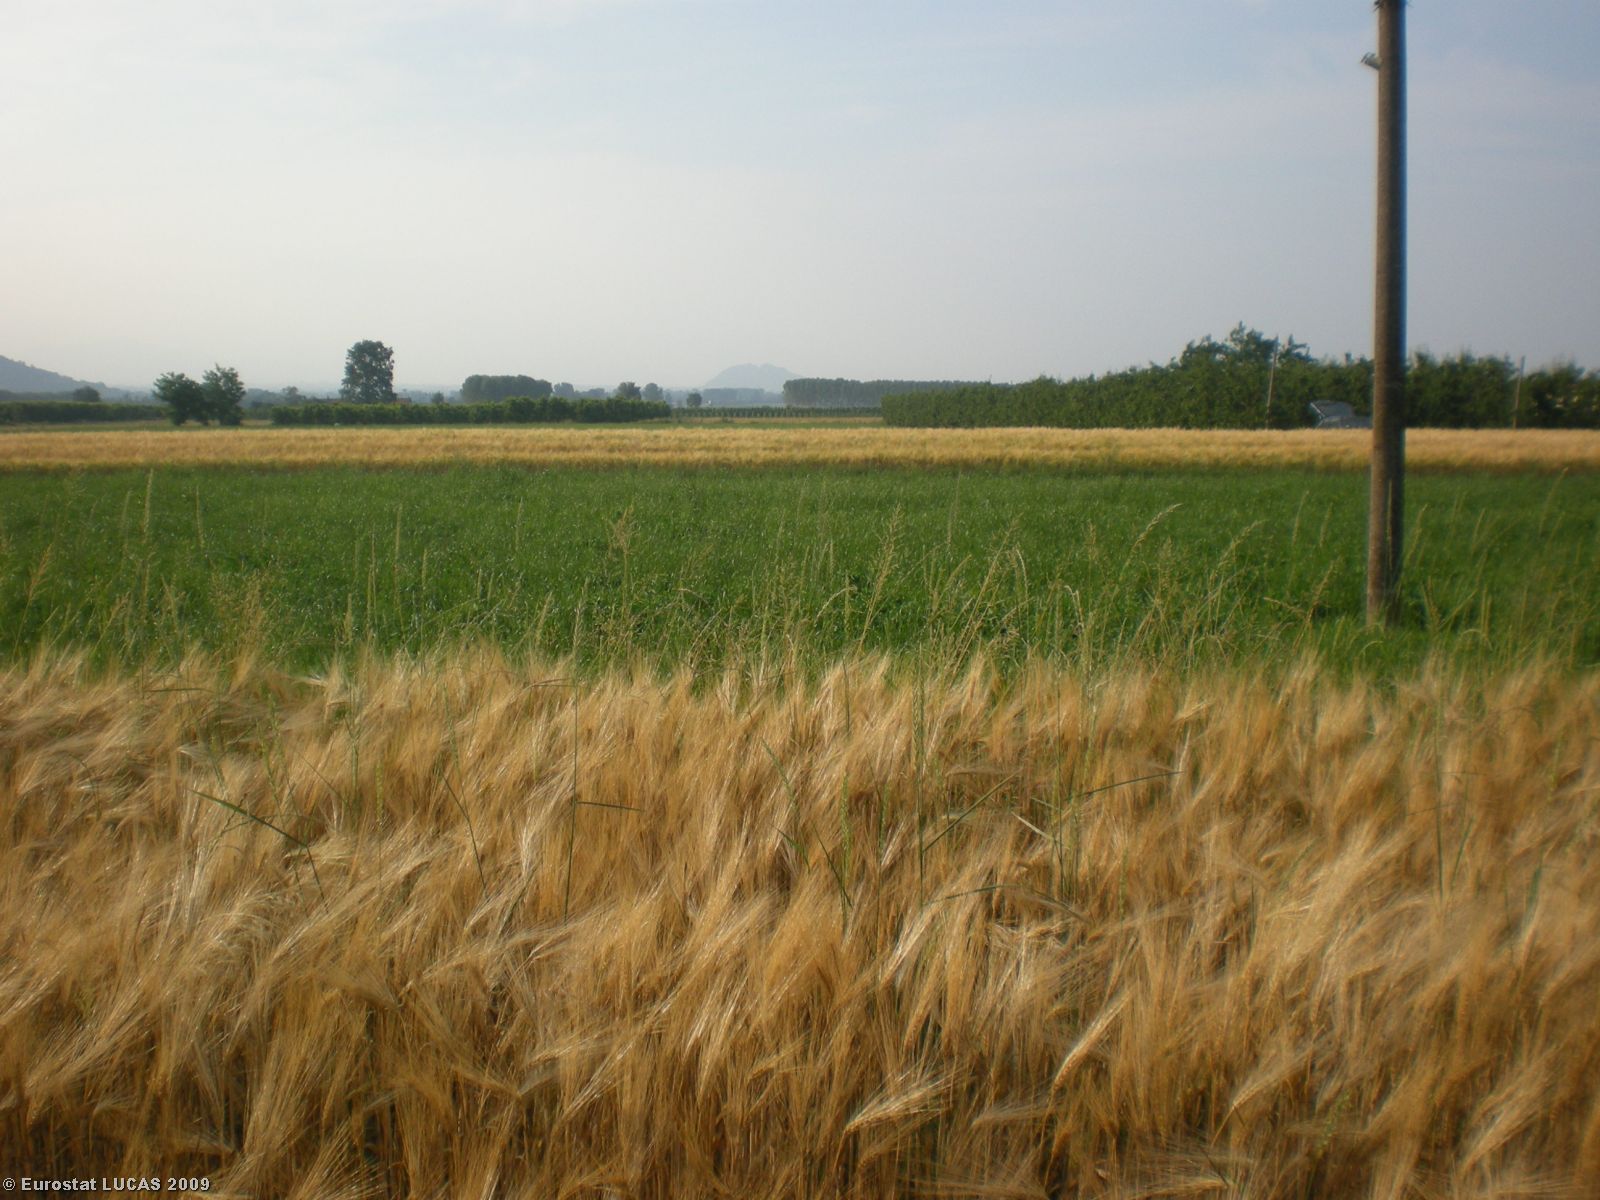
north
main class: Cropland
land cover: Barley
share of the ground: > 75 %
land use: Agriculture (excluding fallow land and kitchen gardens)
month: June
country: IT
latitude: 44.6787
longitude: 7.3936
